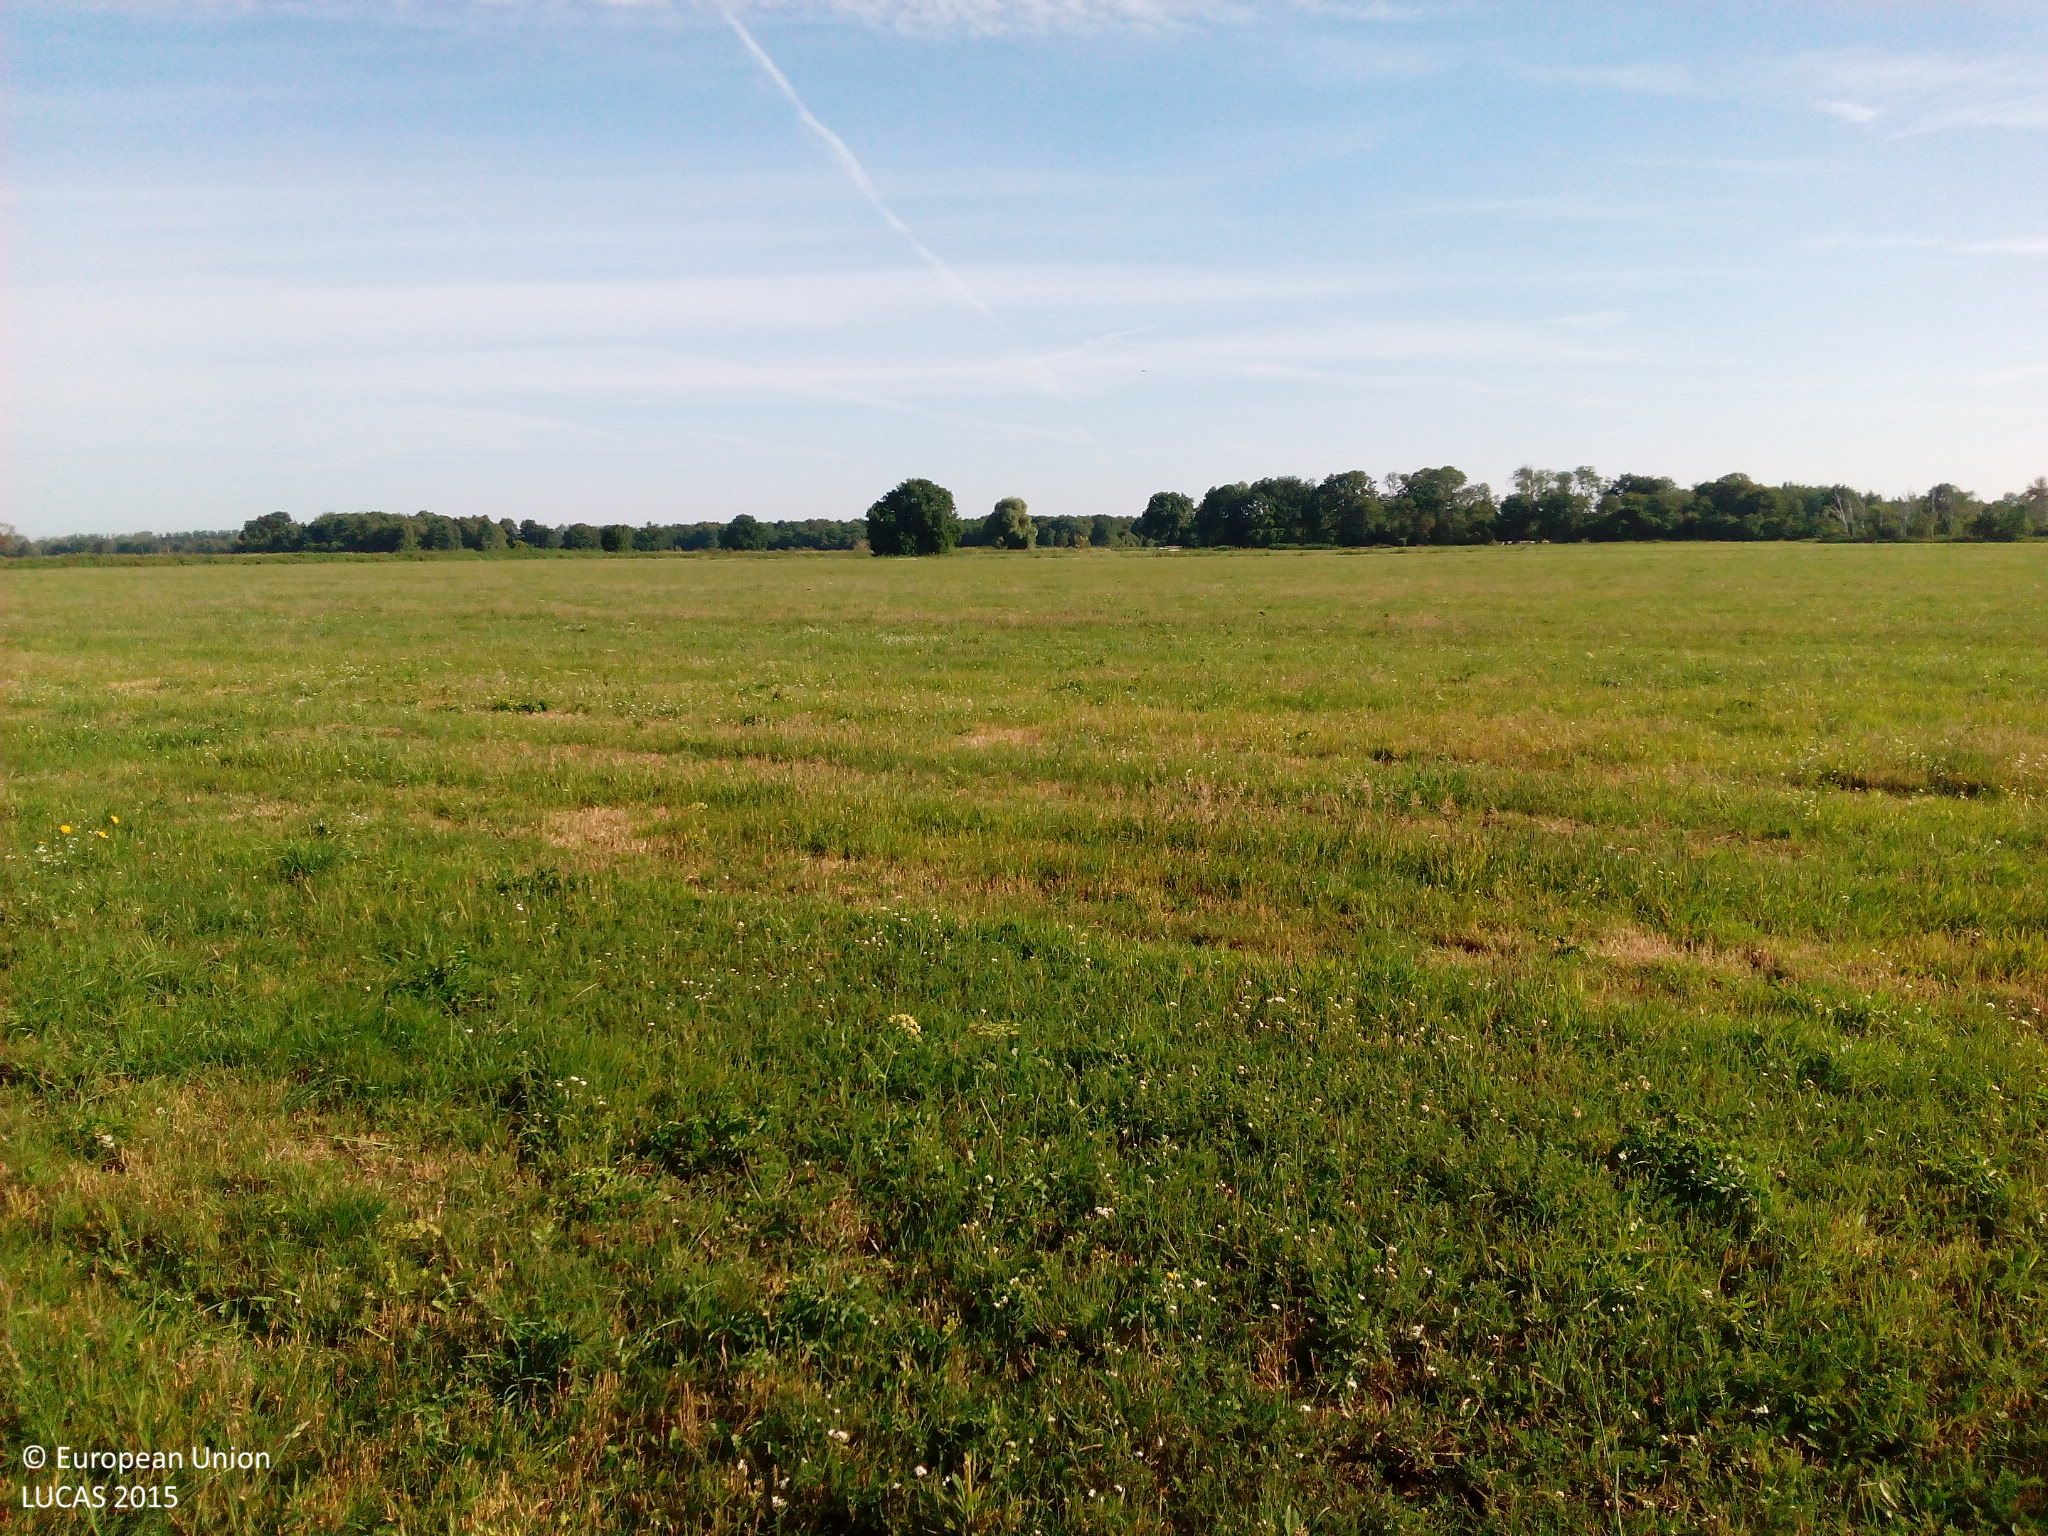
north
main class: Grassland
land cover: Grassland without tree/shrub cover
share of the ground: > 75 %
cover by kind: herbaceous plants 100 %
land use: Agriculture (excluding fallow land and kitchen gardens)
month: July
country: DE
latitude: 53.6861
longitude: 13.7400
